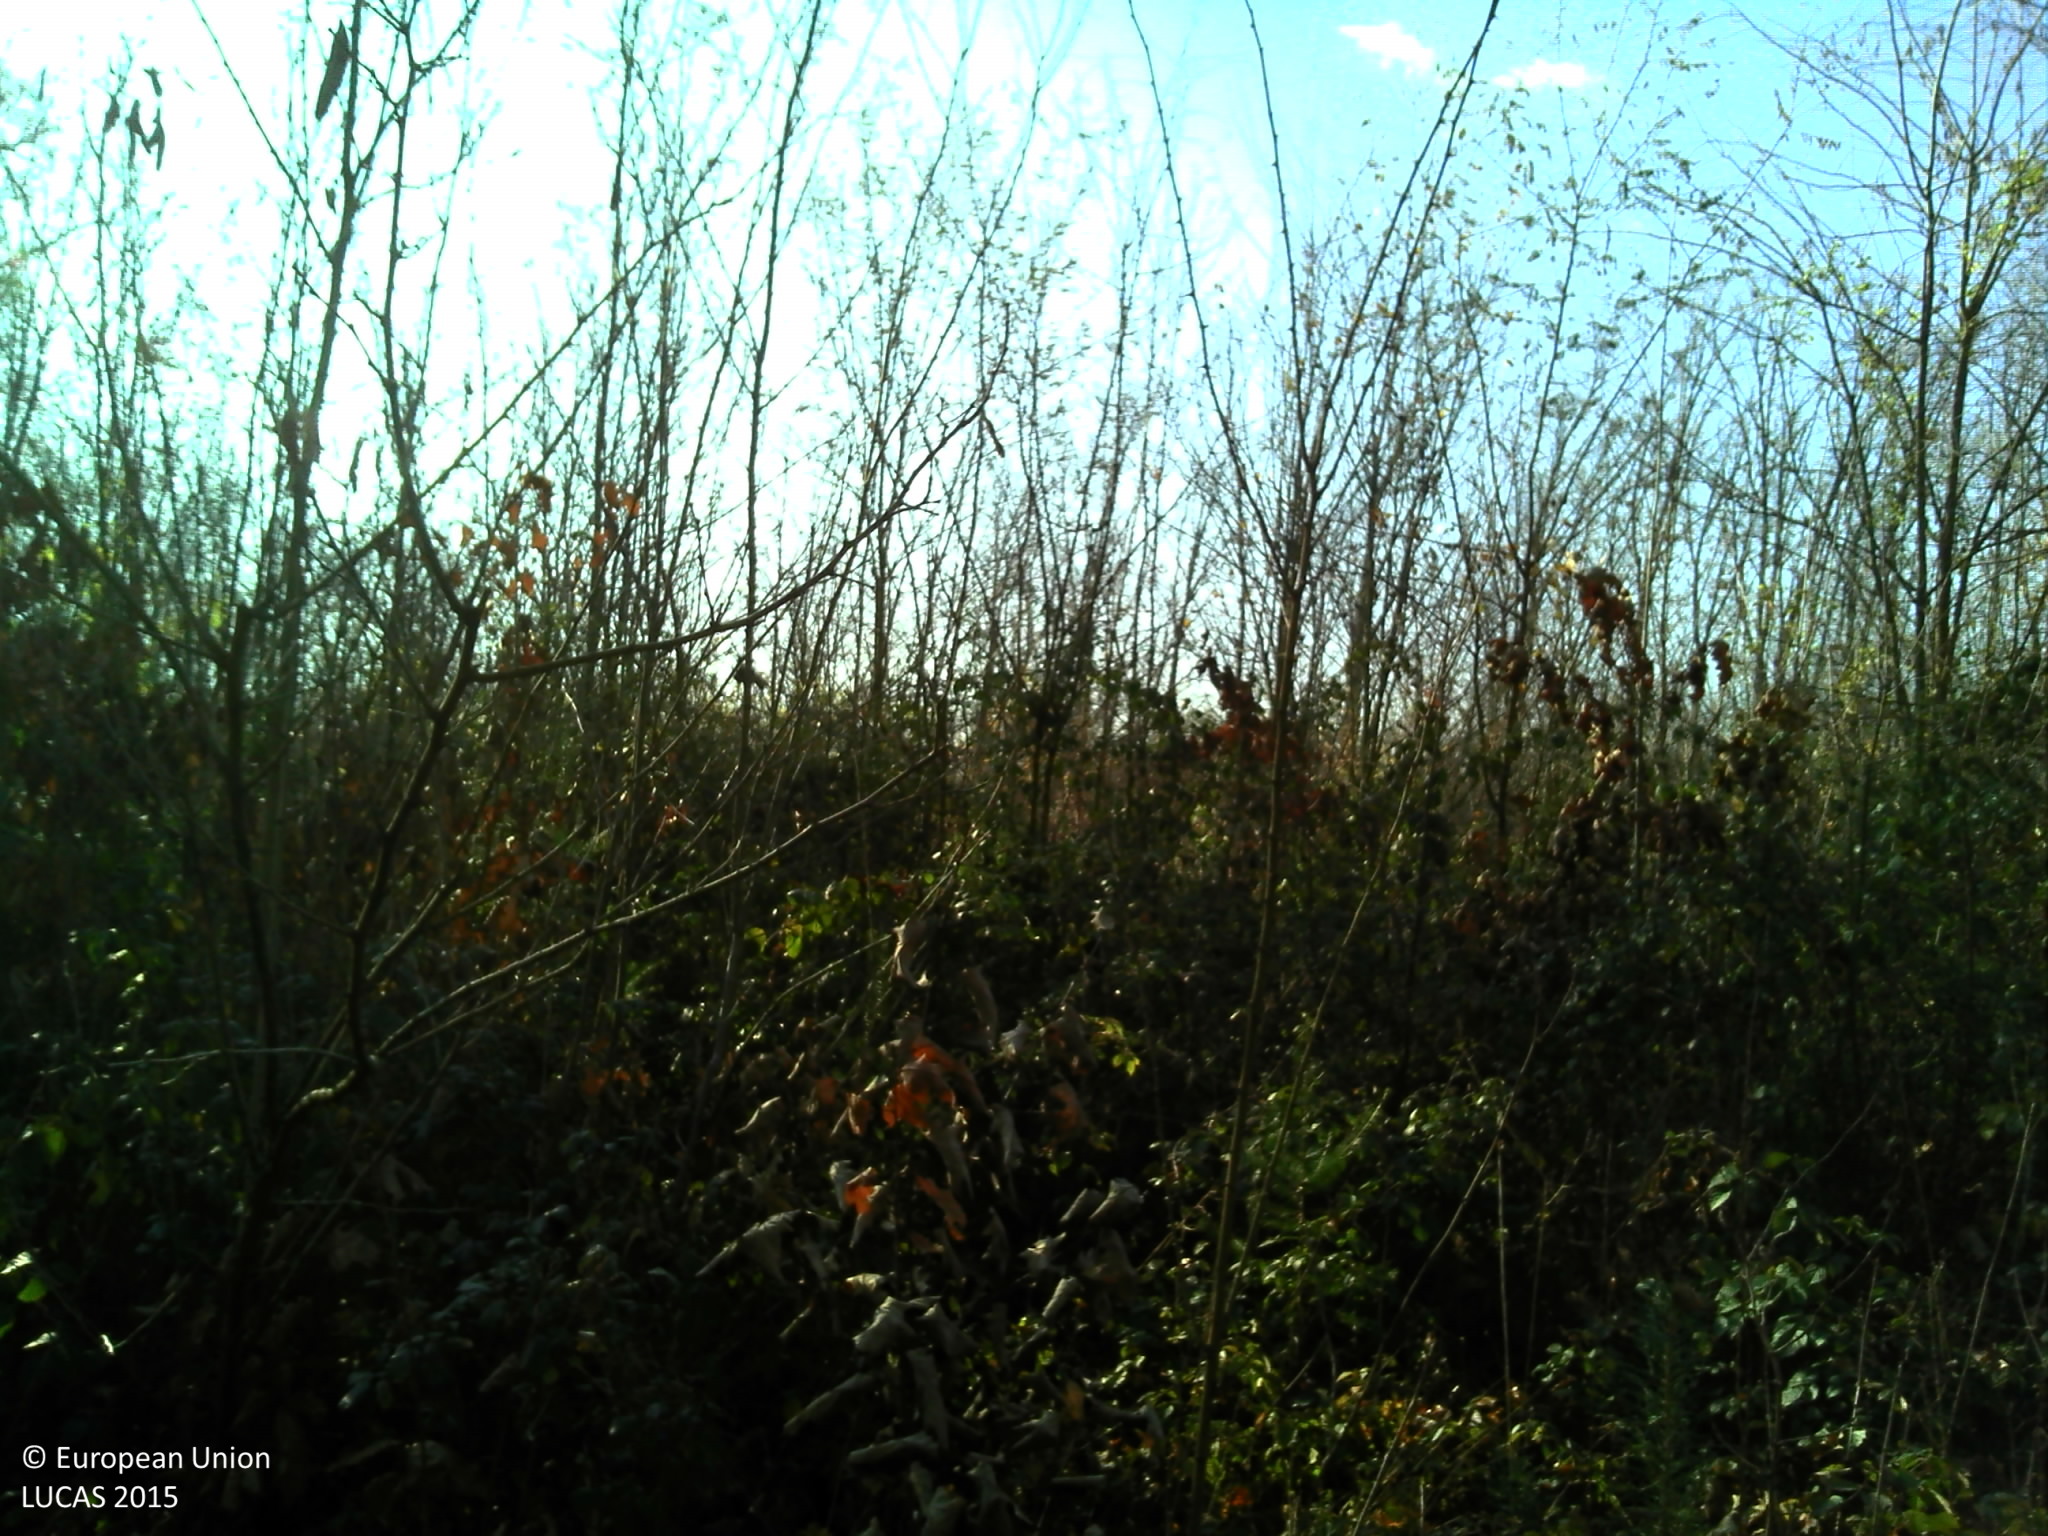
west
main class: Woodland
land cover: Pine dominated mixed woodland
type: mesophytic deciduous forest
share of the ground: > 75 %
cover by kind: coniferous forest trees 45 %, broadleaved forest trees 45 %, herbaceous plants 10 %
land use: Forestry
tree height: > 5 m
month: December
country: FR
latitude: 45.8691
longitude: 5.3018
